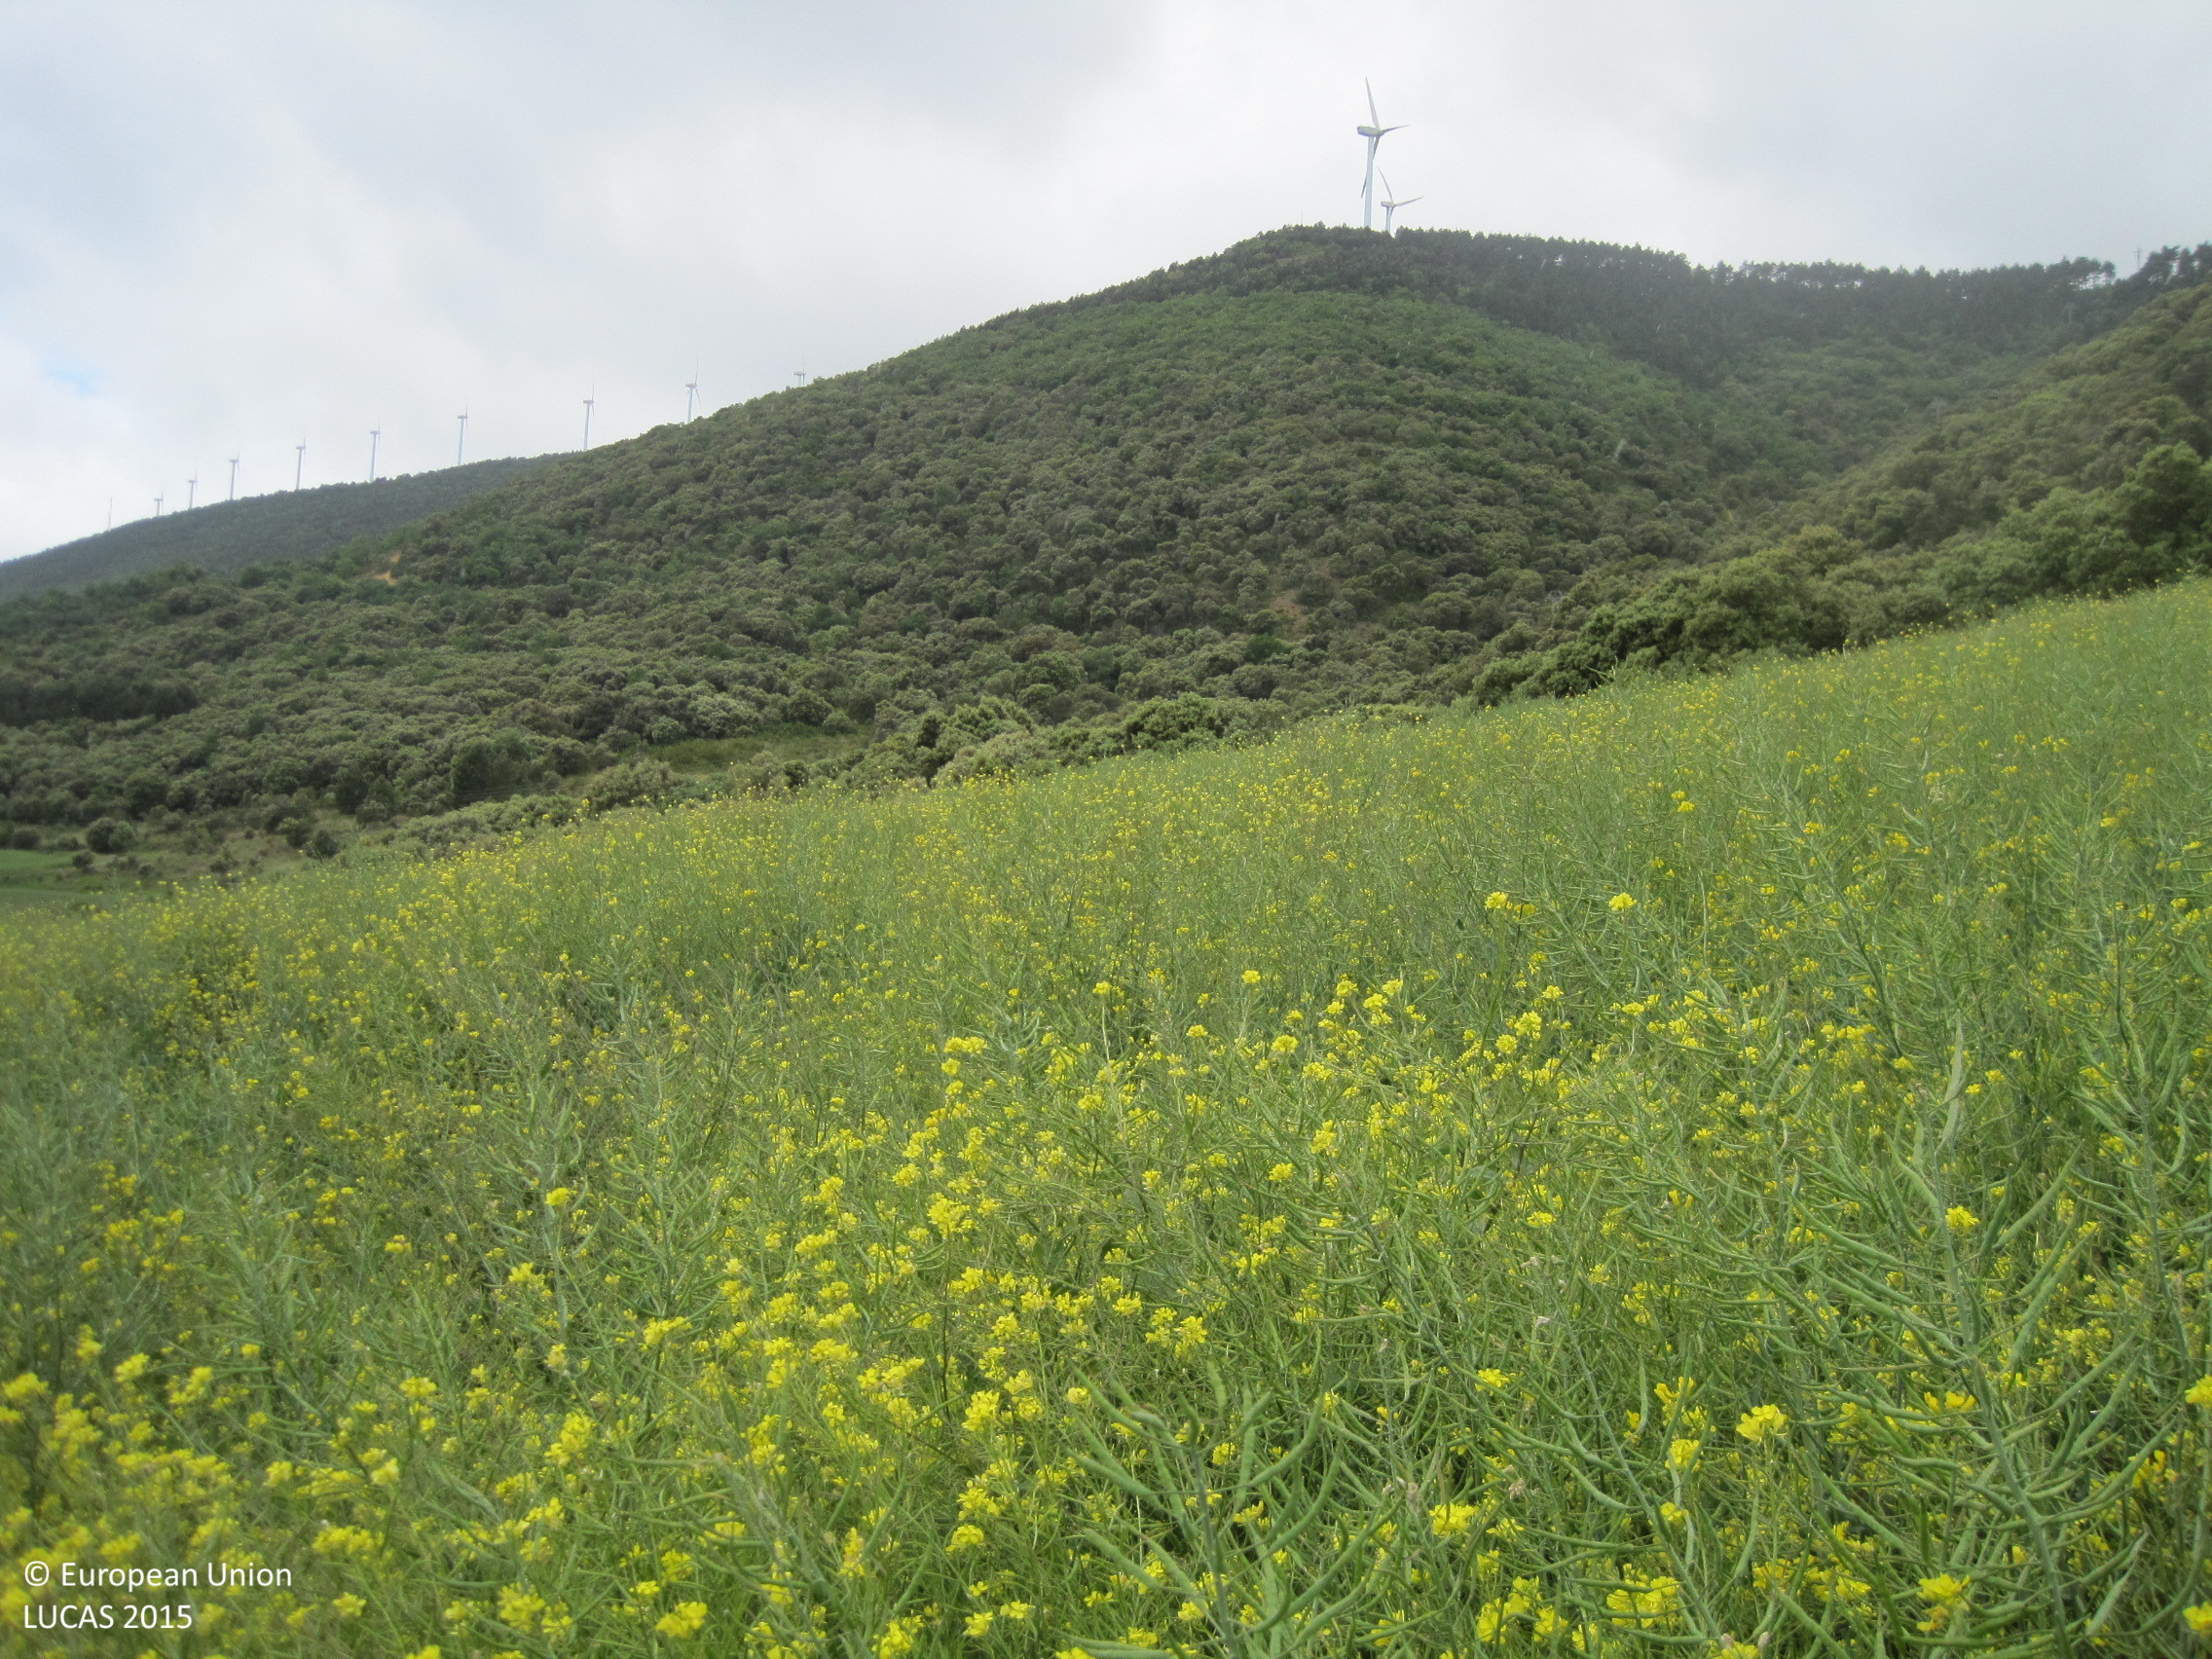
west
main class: Cropland
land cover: Rape and turnip rape
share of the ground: > 75 %
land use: Agriculture (excluding fallow land and kitchen gardens)
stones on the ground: < 10 %
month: May
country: ES
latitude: 42.7235
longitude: -1.6768
